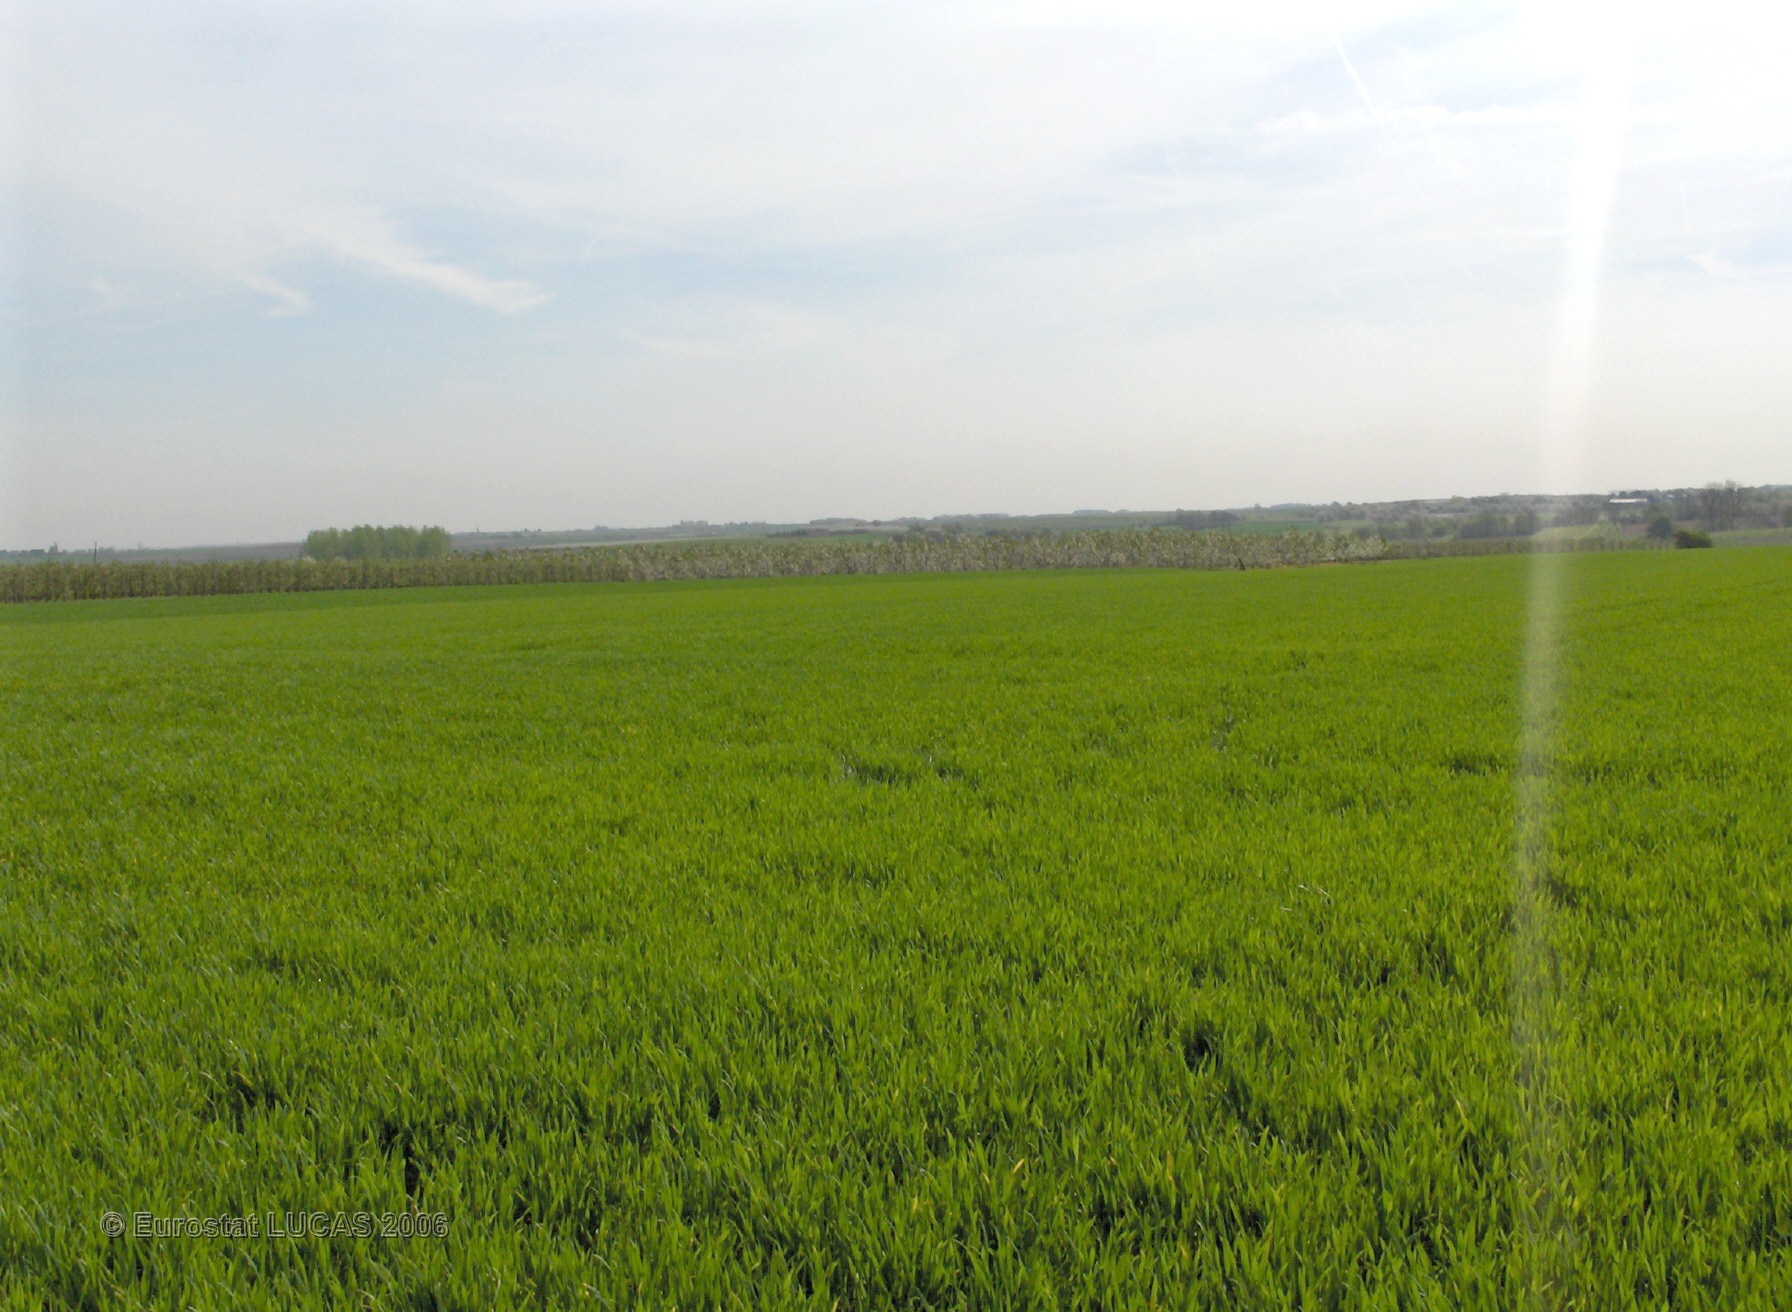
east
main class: Cropland
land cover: Common wheat
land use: Agriculture (excluding fallow land and kitchen gardens)
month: May
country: BE
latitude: 50.7673
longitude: 5.1910
